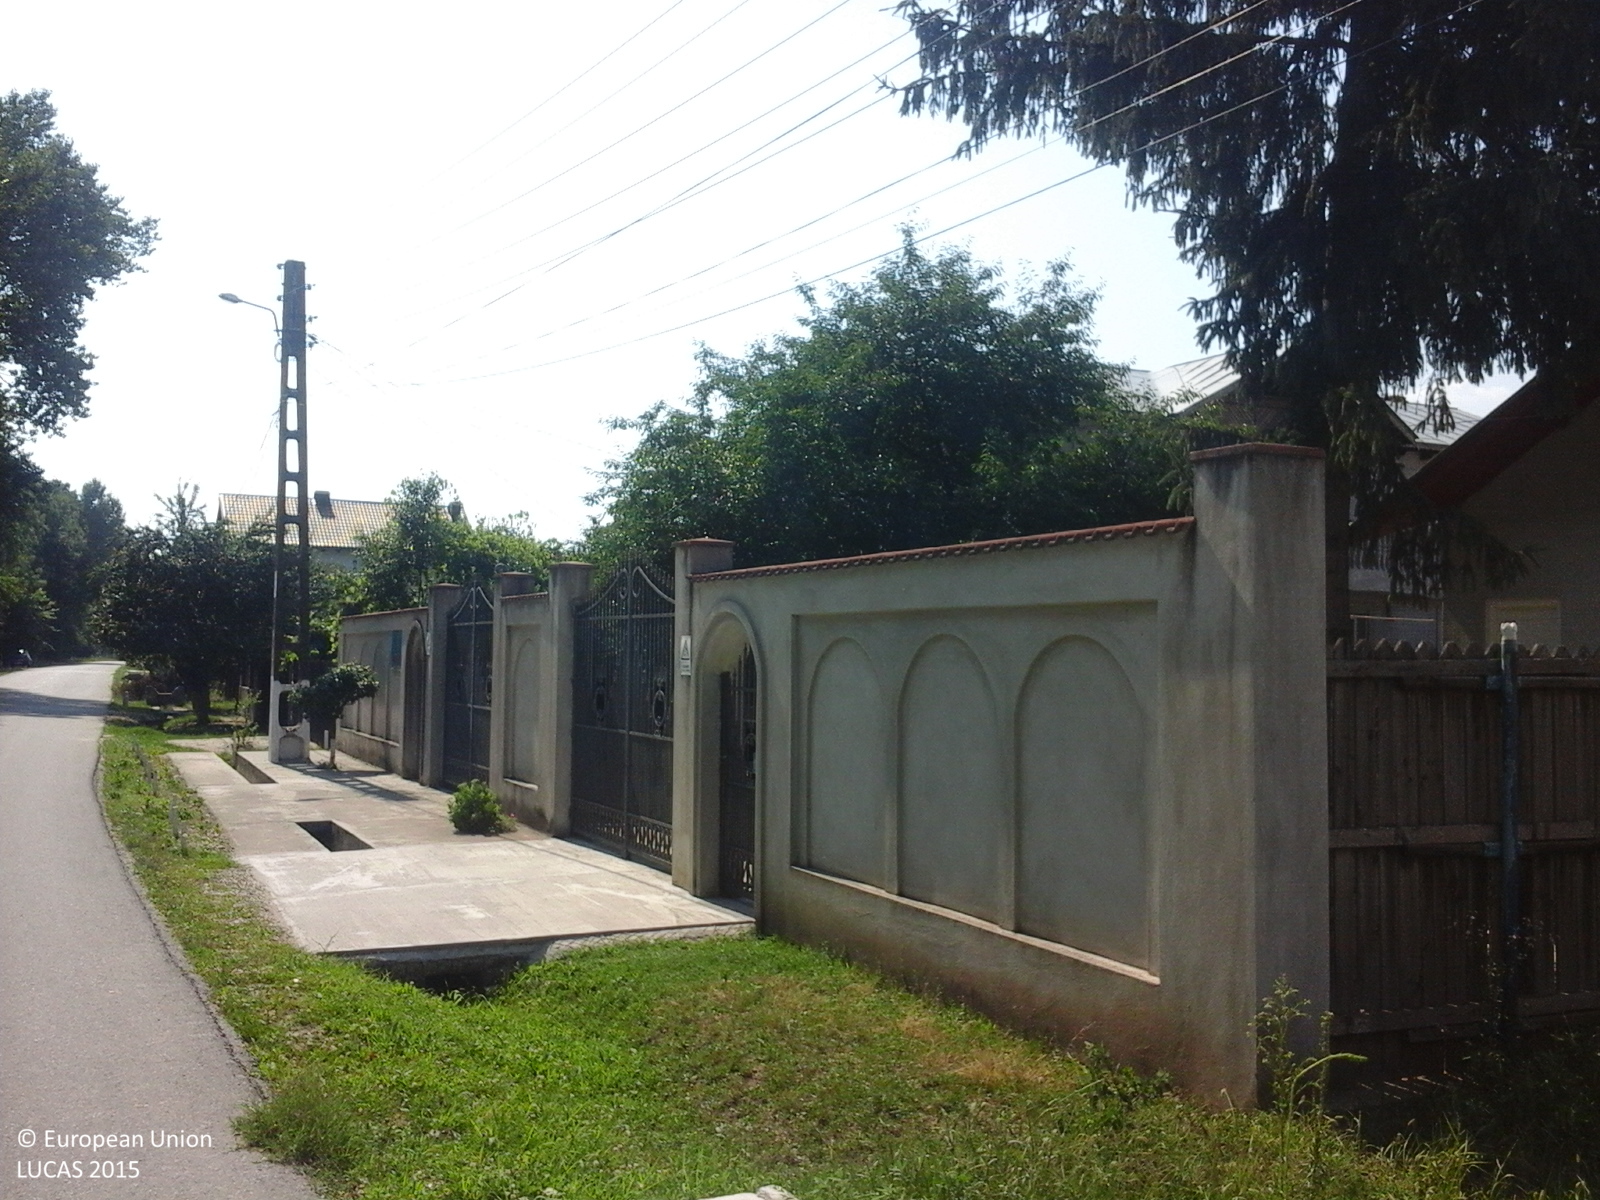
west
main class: Grassland
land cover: Spontaneously vegetated surfaces
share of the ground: > 75 %
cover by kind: herbaceous plants 100 %
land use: Fallow land
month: July
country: RO
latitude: 44.4970
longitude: 25.6264
